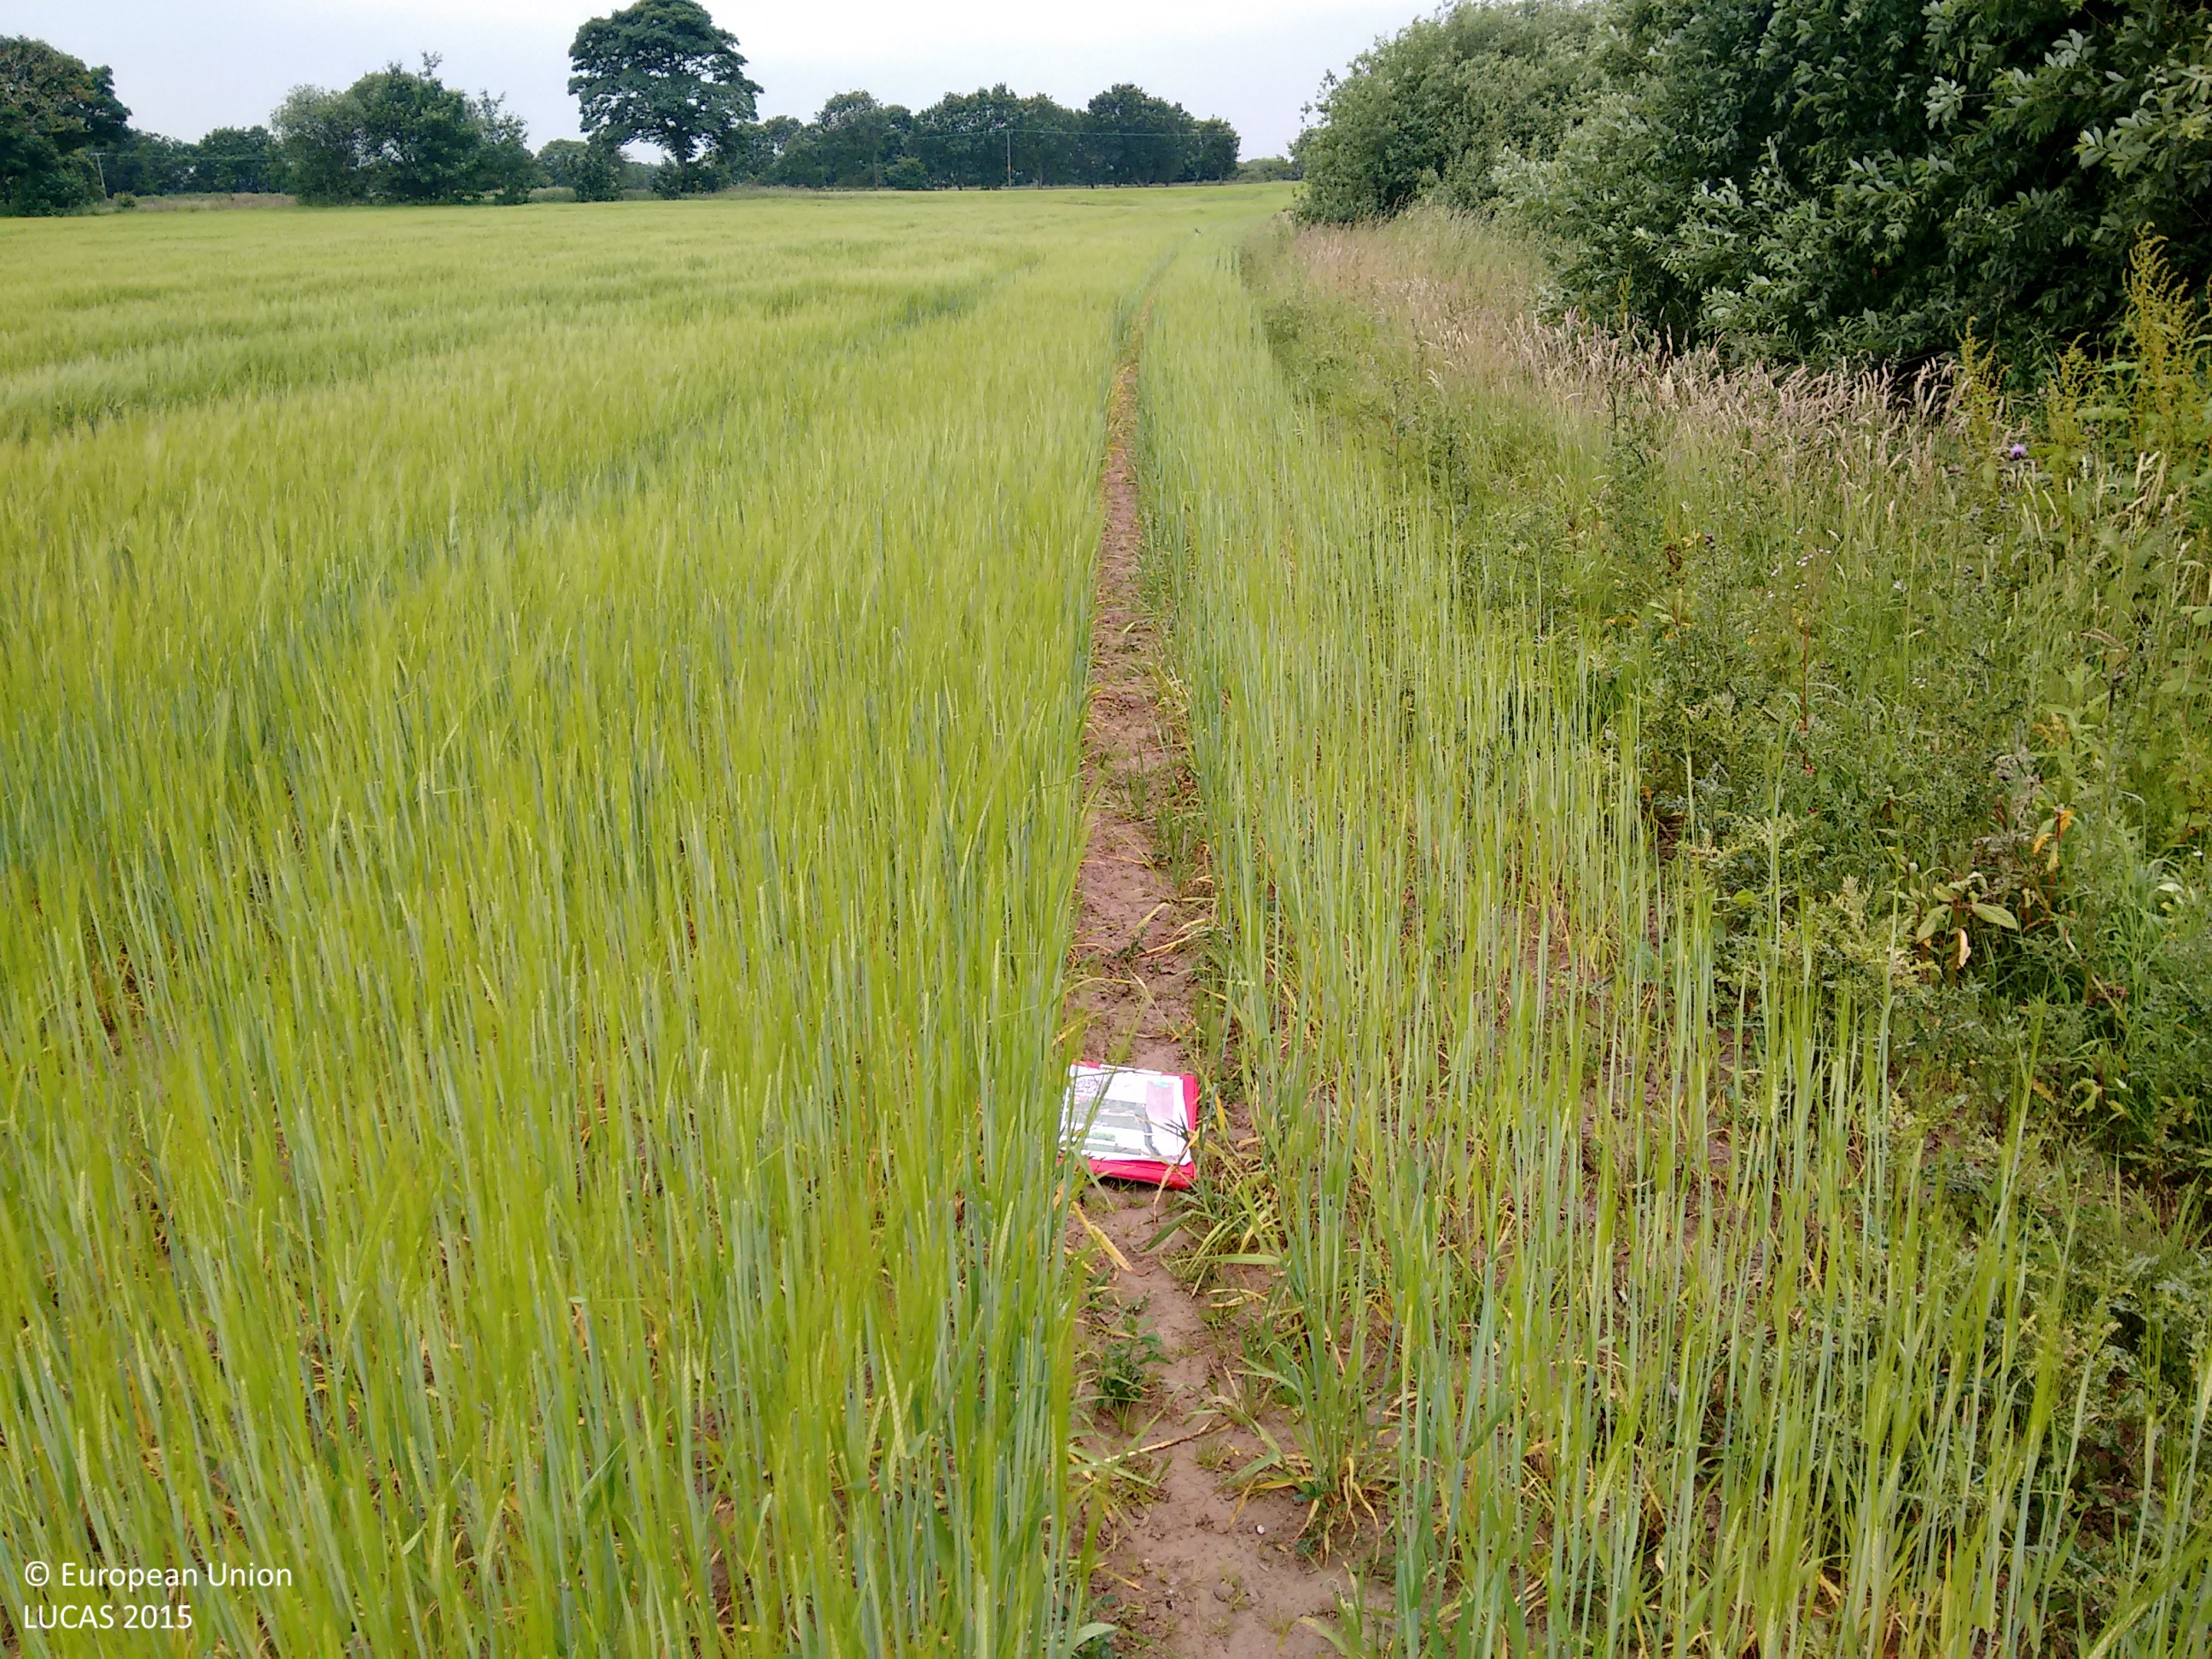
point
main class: Cropland
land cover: Barley
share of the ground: > 75 %
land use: Agriculture (excluding fallow land and kitchen gardens)
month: July
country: GB
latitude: 53.4826
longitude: -2.4670
